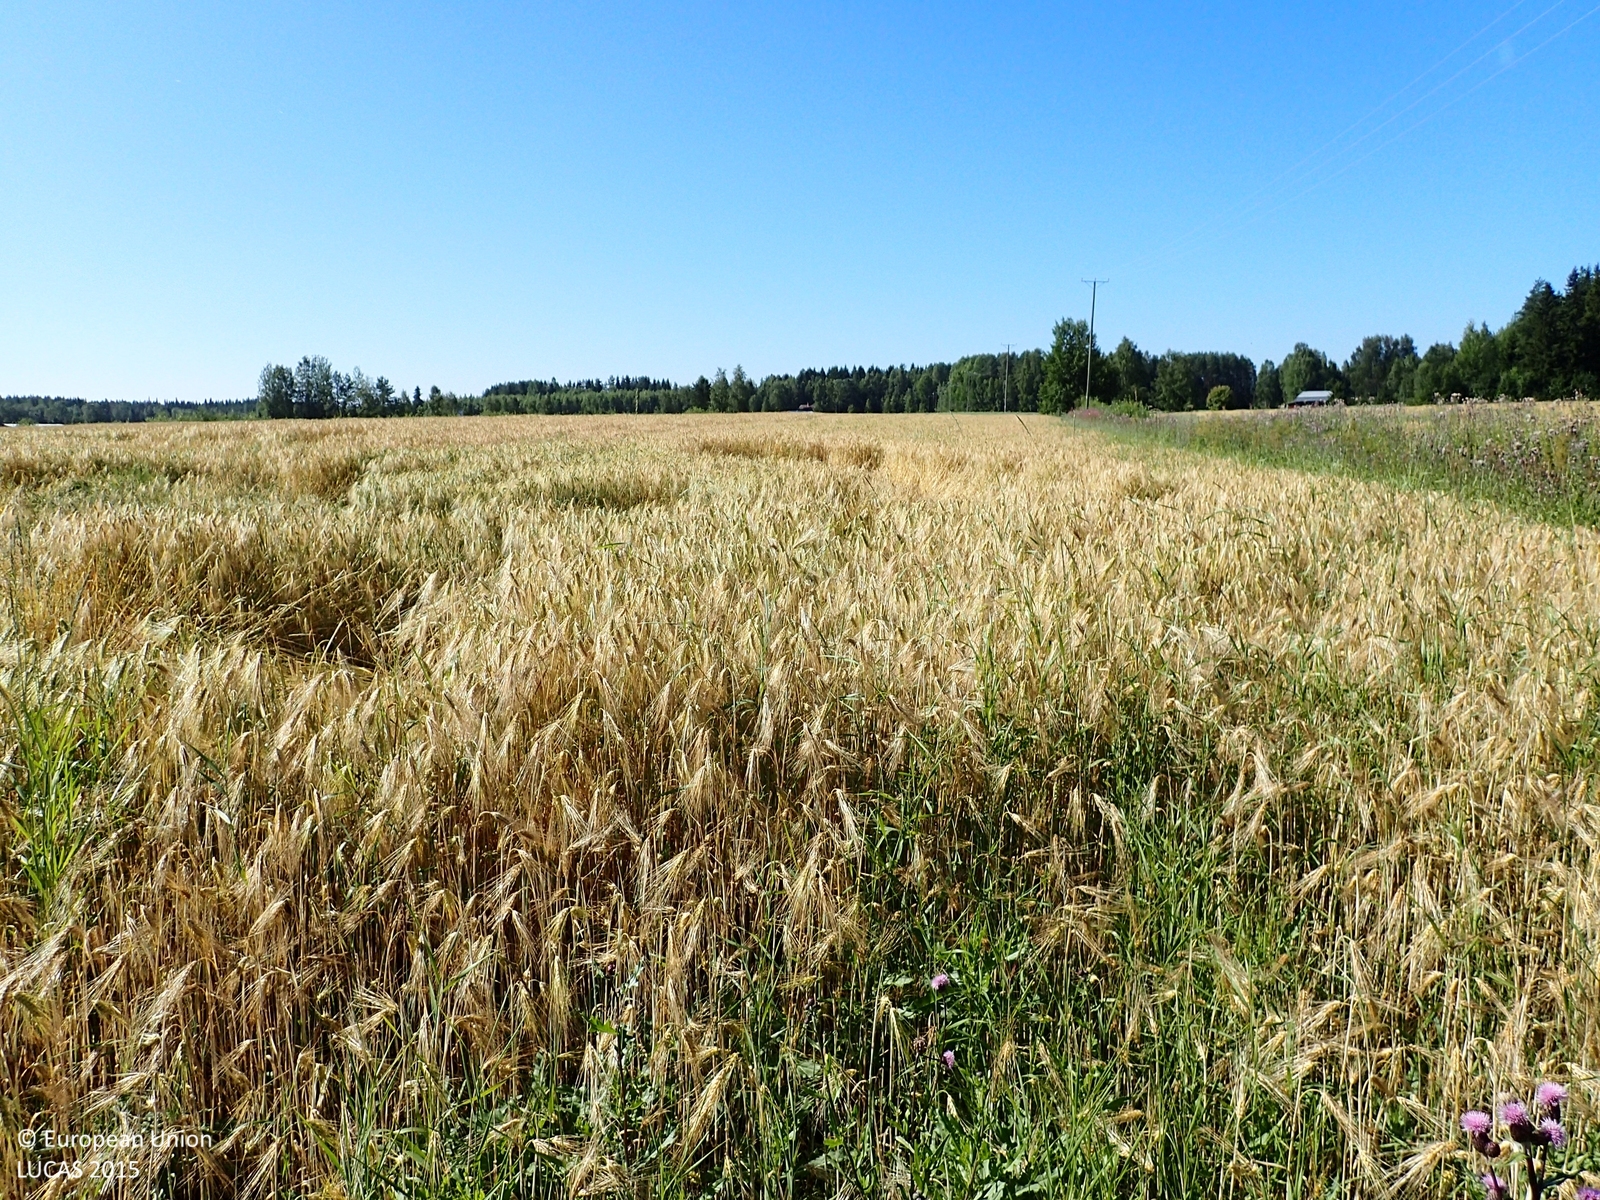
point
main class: Cropland
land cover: Barley
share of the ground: > 75 %
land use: Agriculture (excluding fallow land and kitchen gardens)
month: August
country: FI
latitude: 62.5354
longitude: 22.6321
